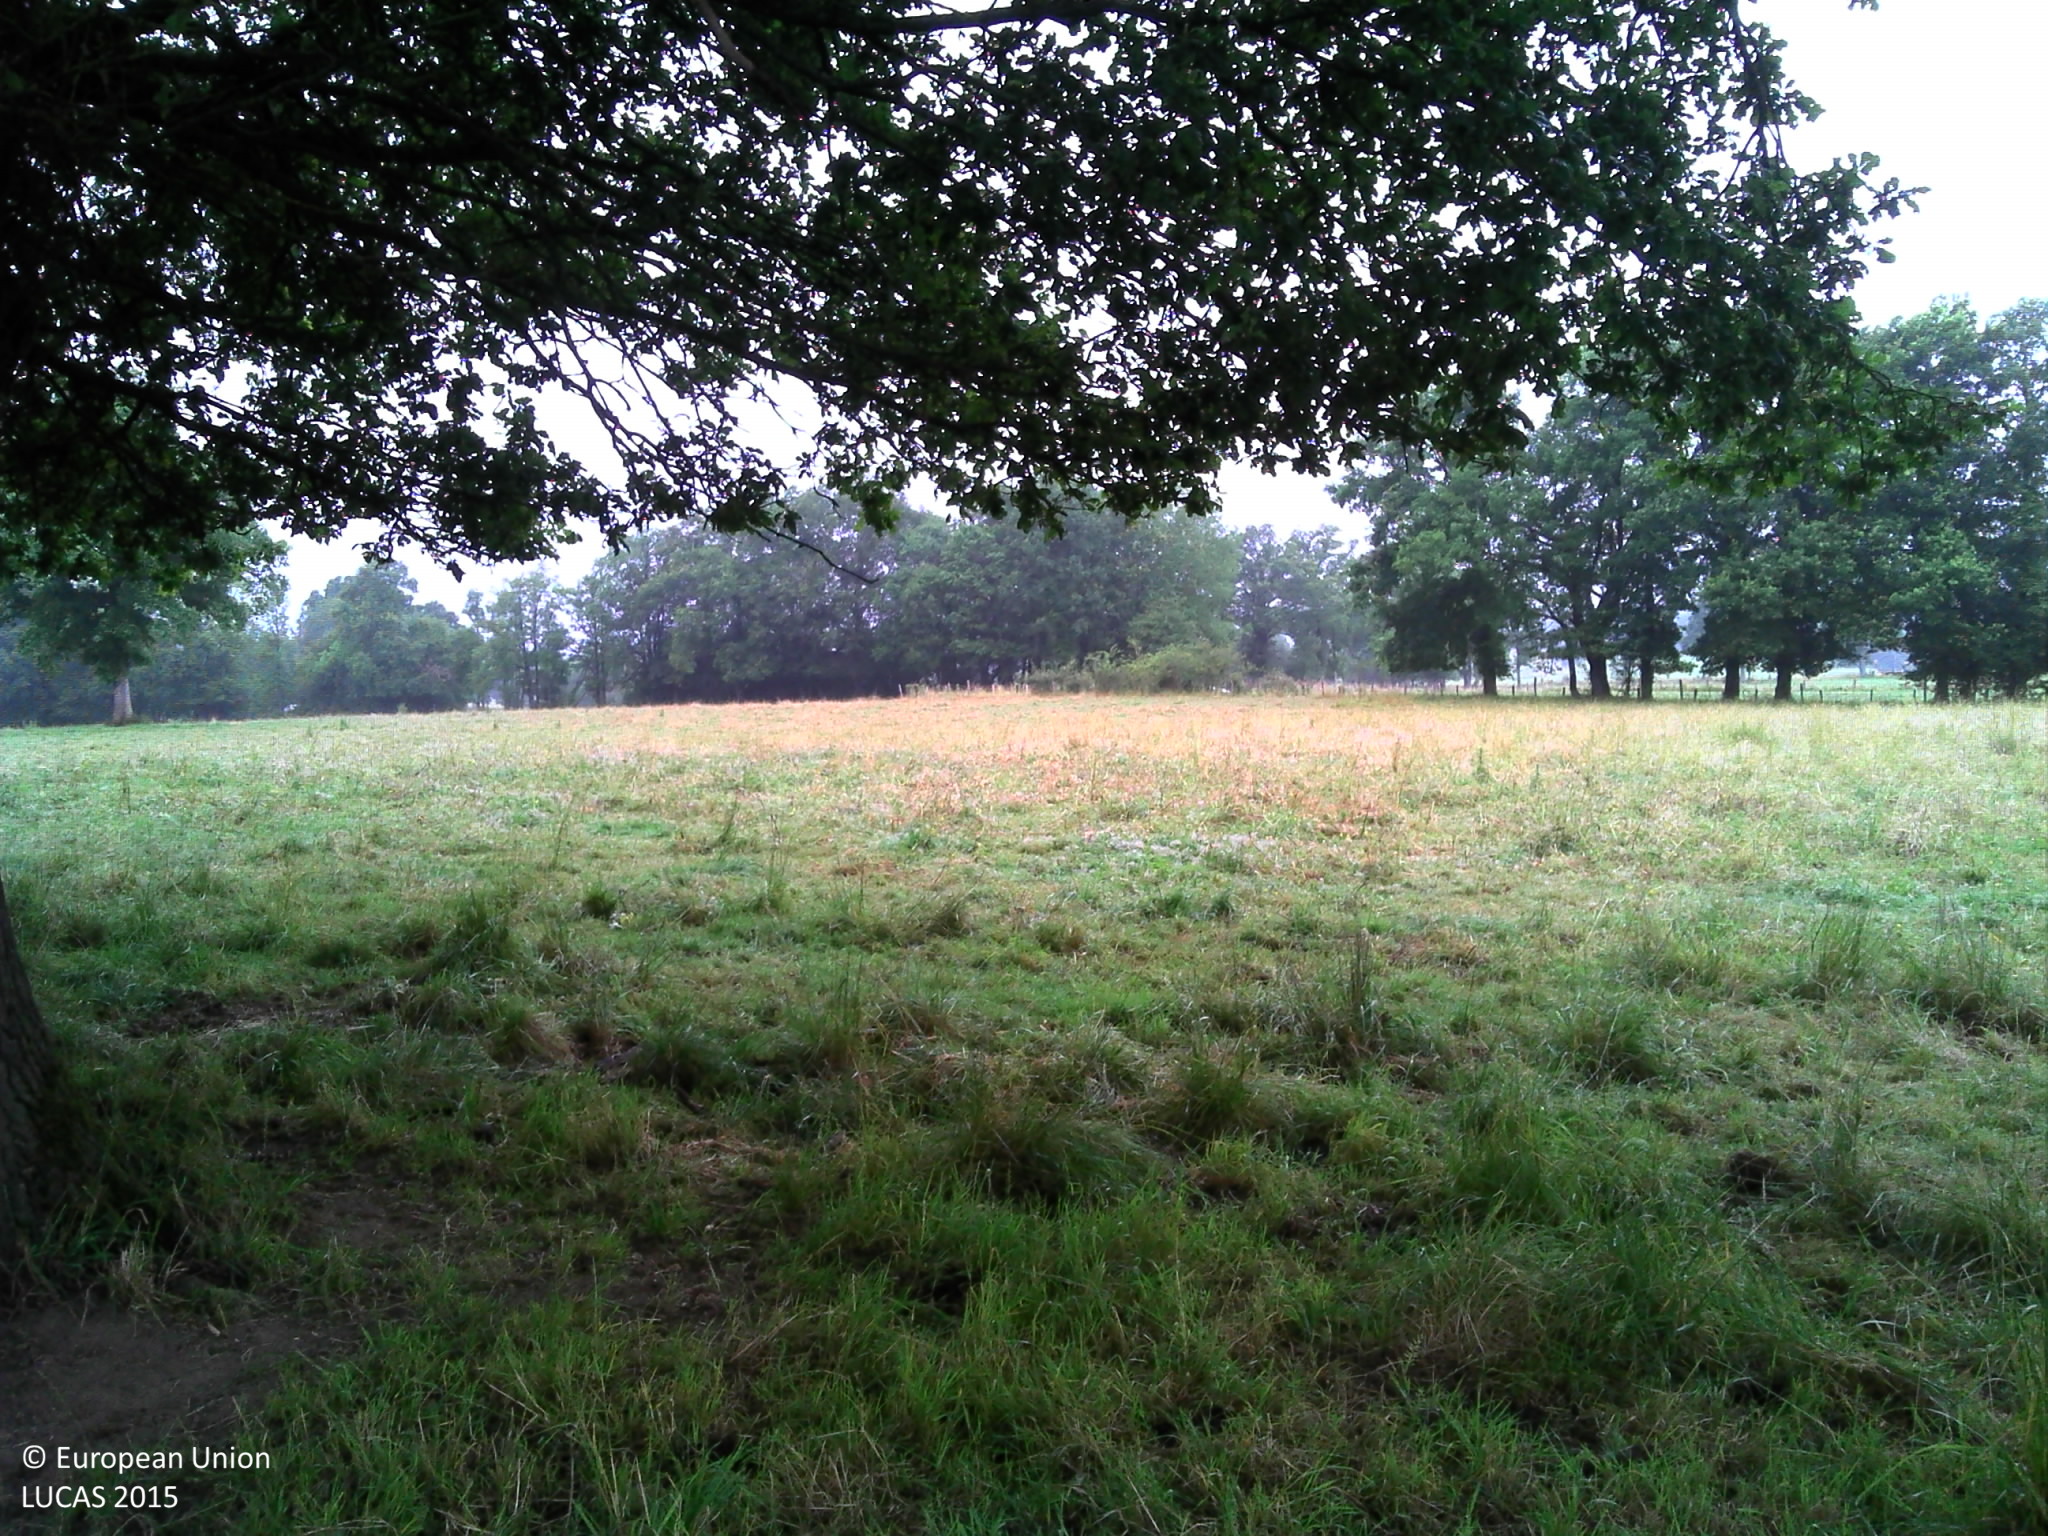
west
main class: Grassland
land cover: Grassland with sparse tree/shrub cover
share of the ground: > 75 %
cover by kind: herbaceous plants 95 %, coniferous forest trees 5 %
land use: Agriculture (excluding fallow land and kitchen gardens)
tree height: > 5 m
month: June
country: FR
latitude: 45.7899
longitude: 0.5828
